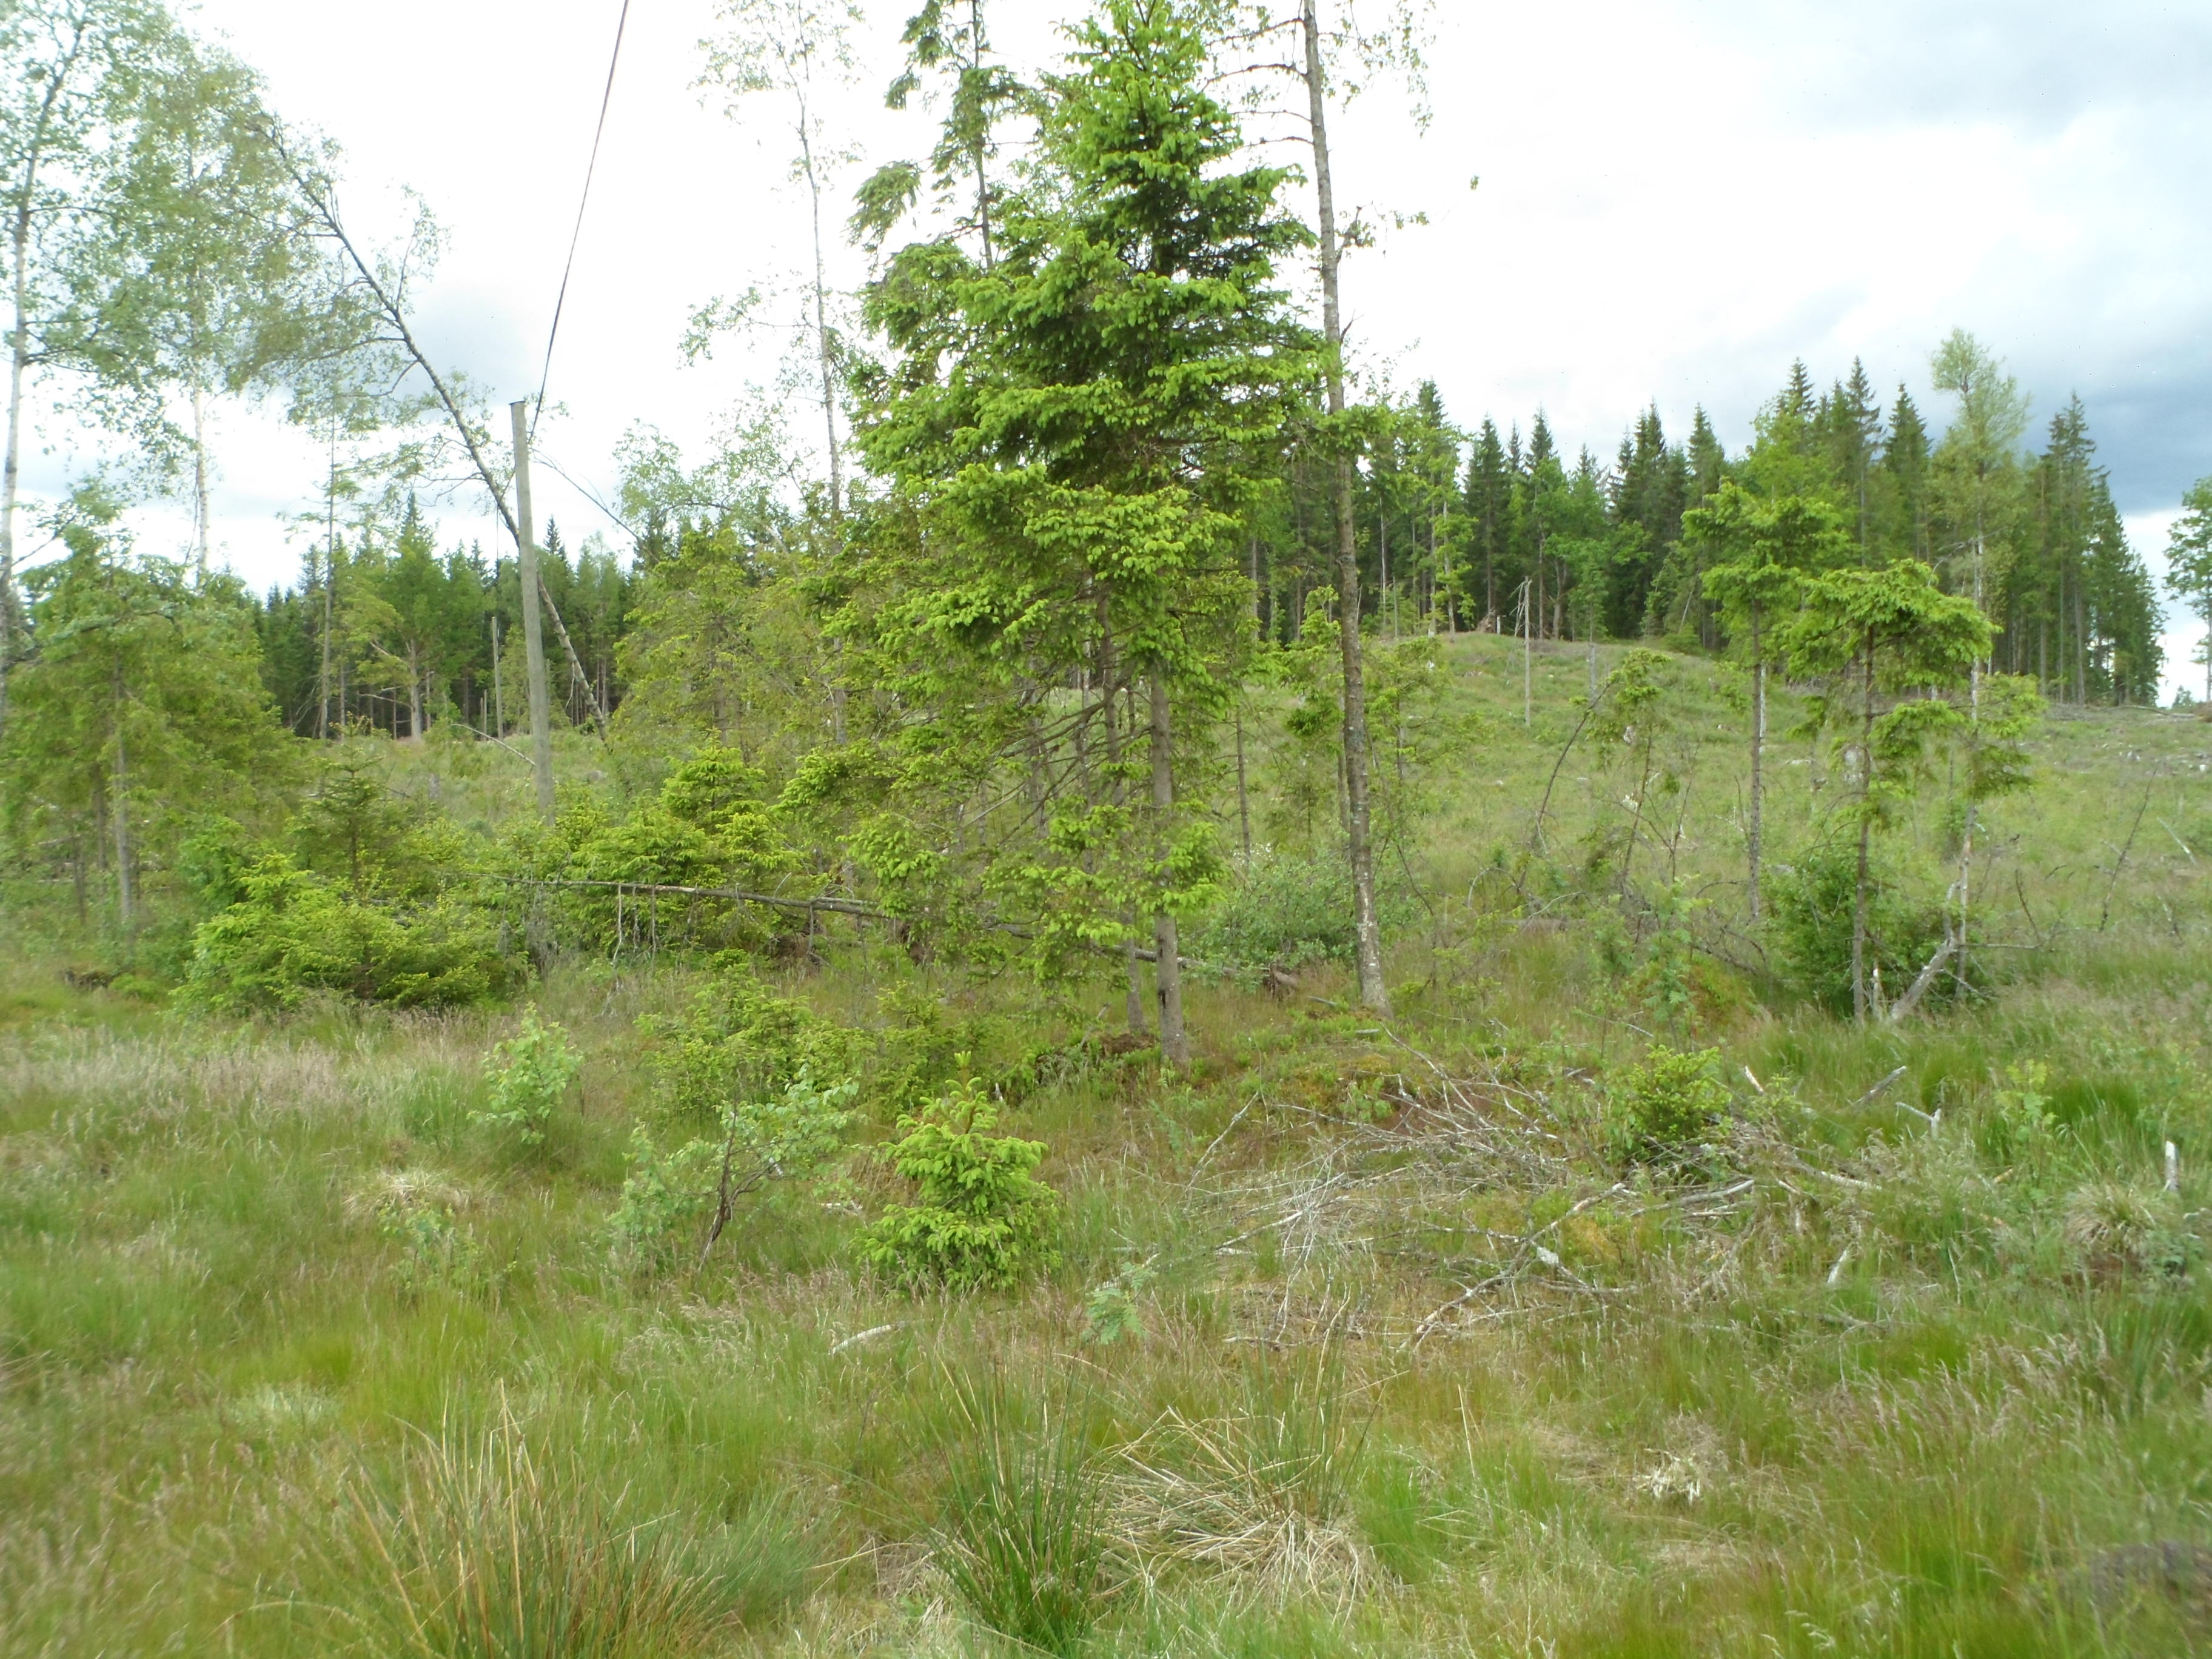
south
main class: Grassland
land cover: Grassland with sparse tree/shrub cover
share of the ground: < 10 %
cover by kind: herbaceous plants 75 %, lichens and mosses 10 %, broadleaved forest trees 5 %, shrubs 5 %, unconsolidated bare surface 5 %
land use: Forestry
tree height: < 5 m
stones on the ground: 25 - 50 %
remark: Clear cut
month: June
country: SE
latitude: 57.3930
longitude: 14.3384
